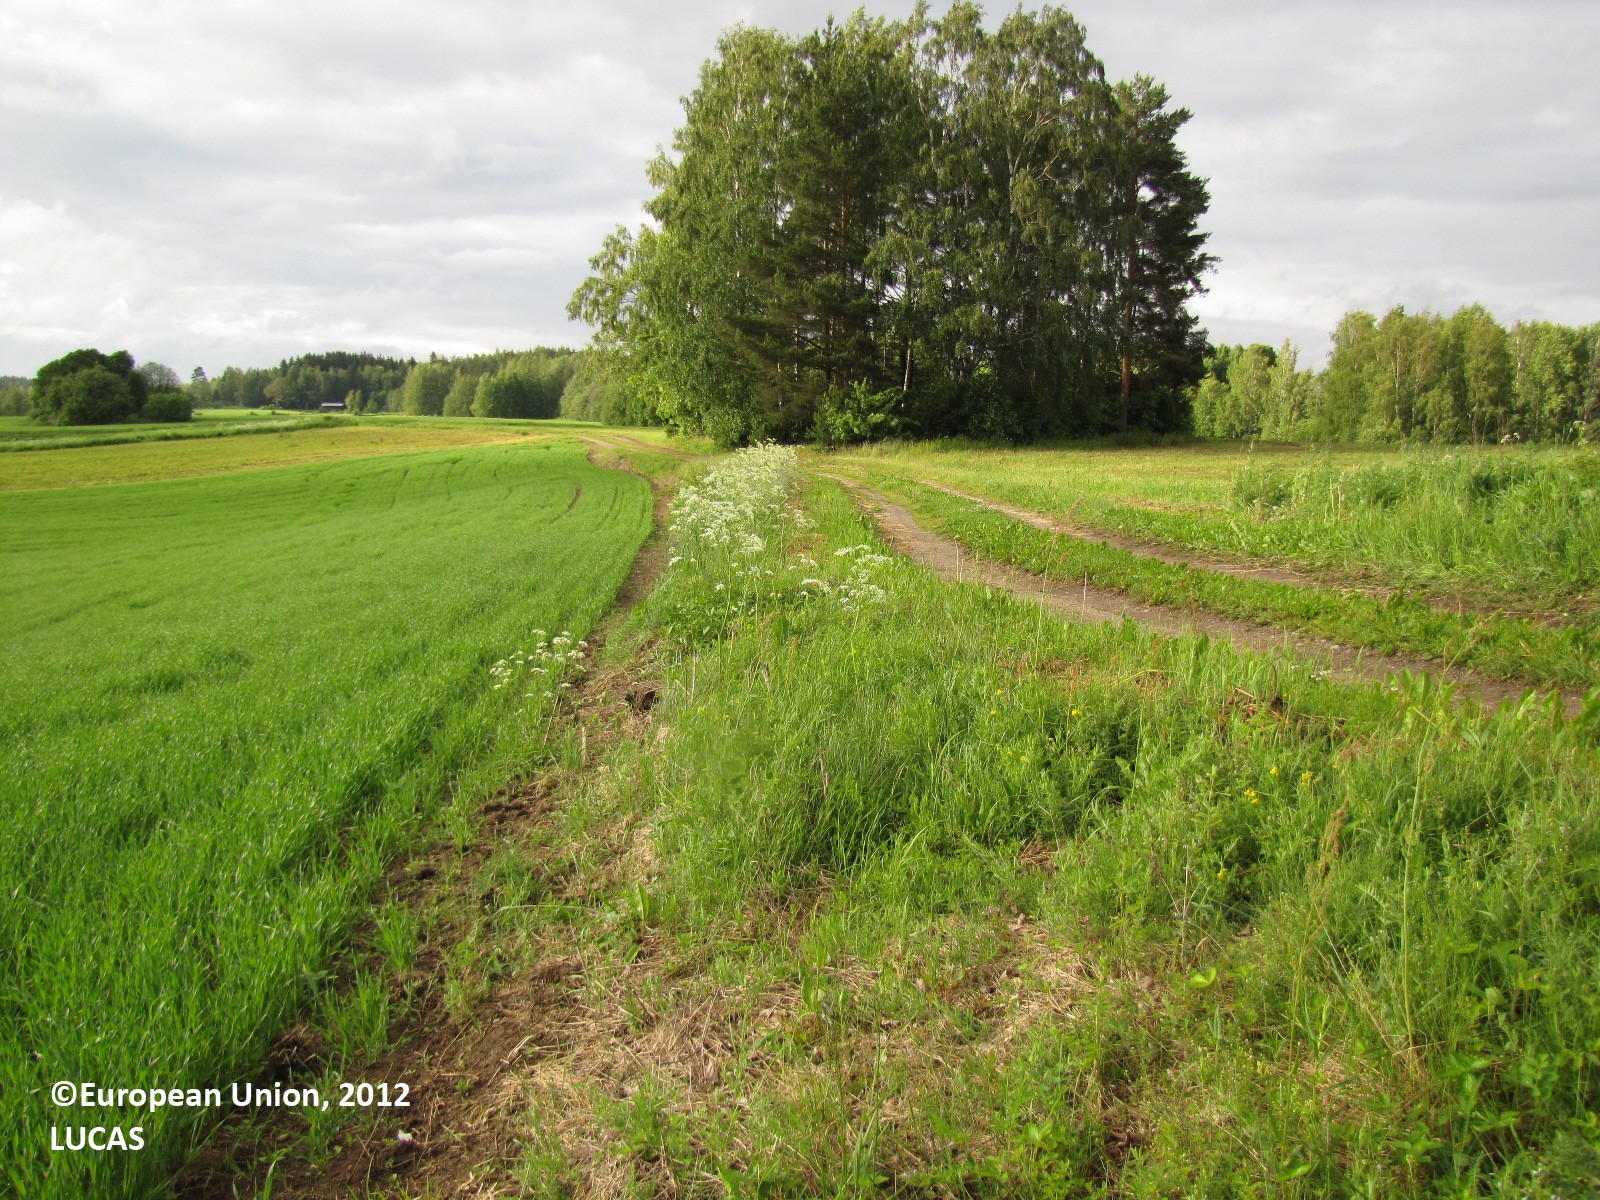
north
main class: Cropland
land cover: Barley
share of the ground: 50 - 75 %
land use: Agriculture (excluding fallow land and kitchen gardens)
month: June
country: FI
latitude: 61.2356
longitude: 24.5770
